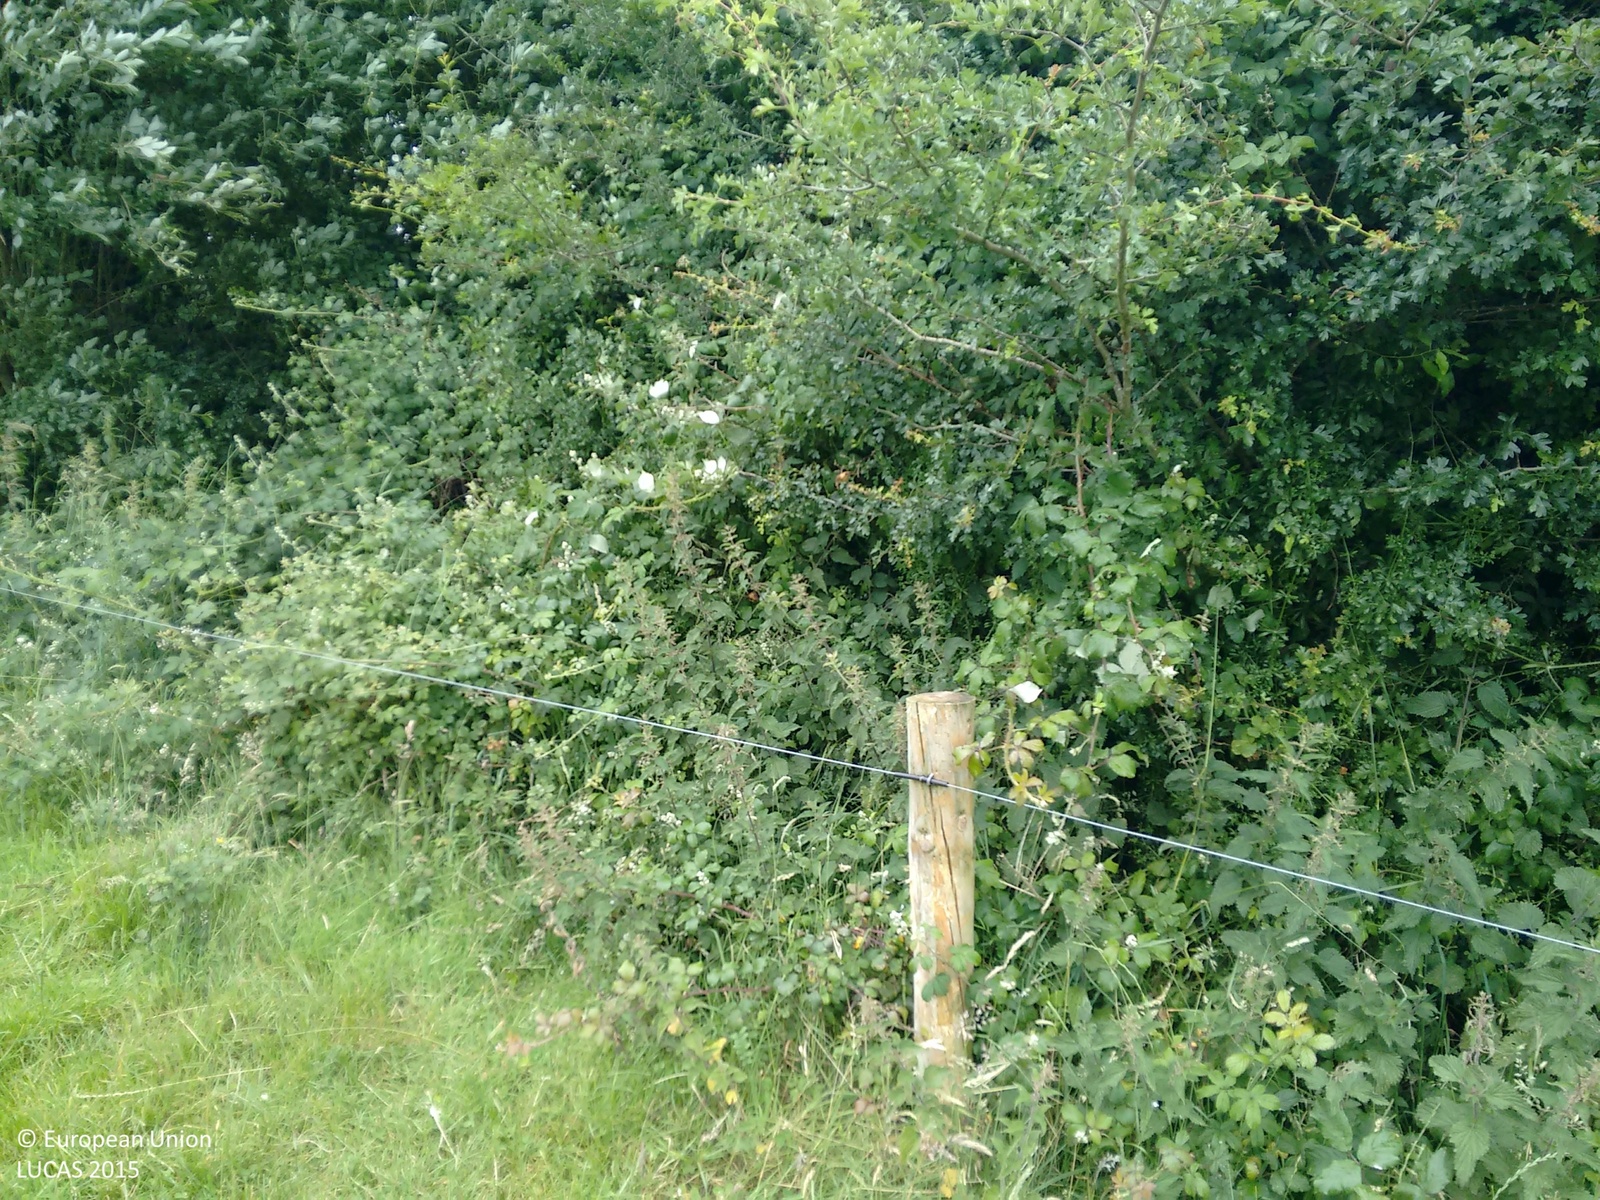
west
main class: Grassland
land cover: Grassland without tree/shrub cover
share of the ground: > 75 %
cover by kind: herbaceous plants 95 %, unconsolidated bare surface 5 %
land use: Agriculture (excluding fallow land and kitchen gardens)
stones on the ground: < 10 %
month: July
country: IE
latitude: 52.6780
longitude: -7.5392
